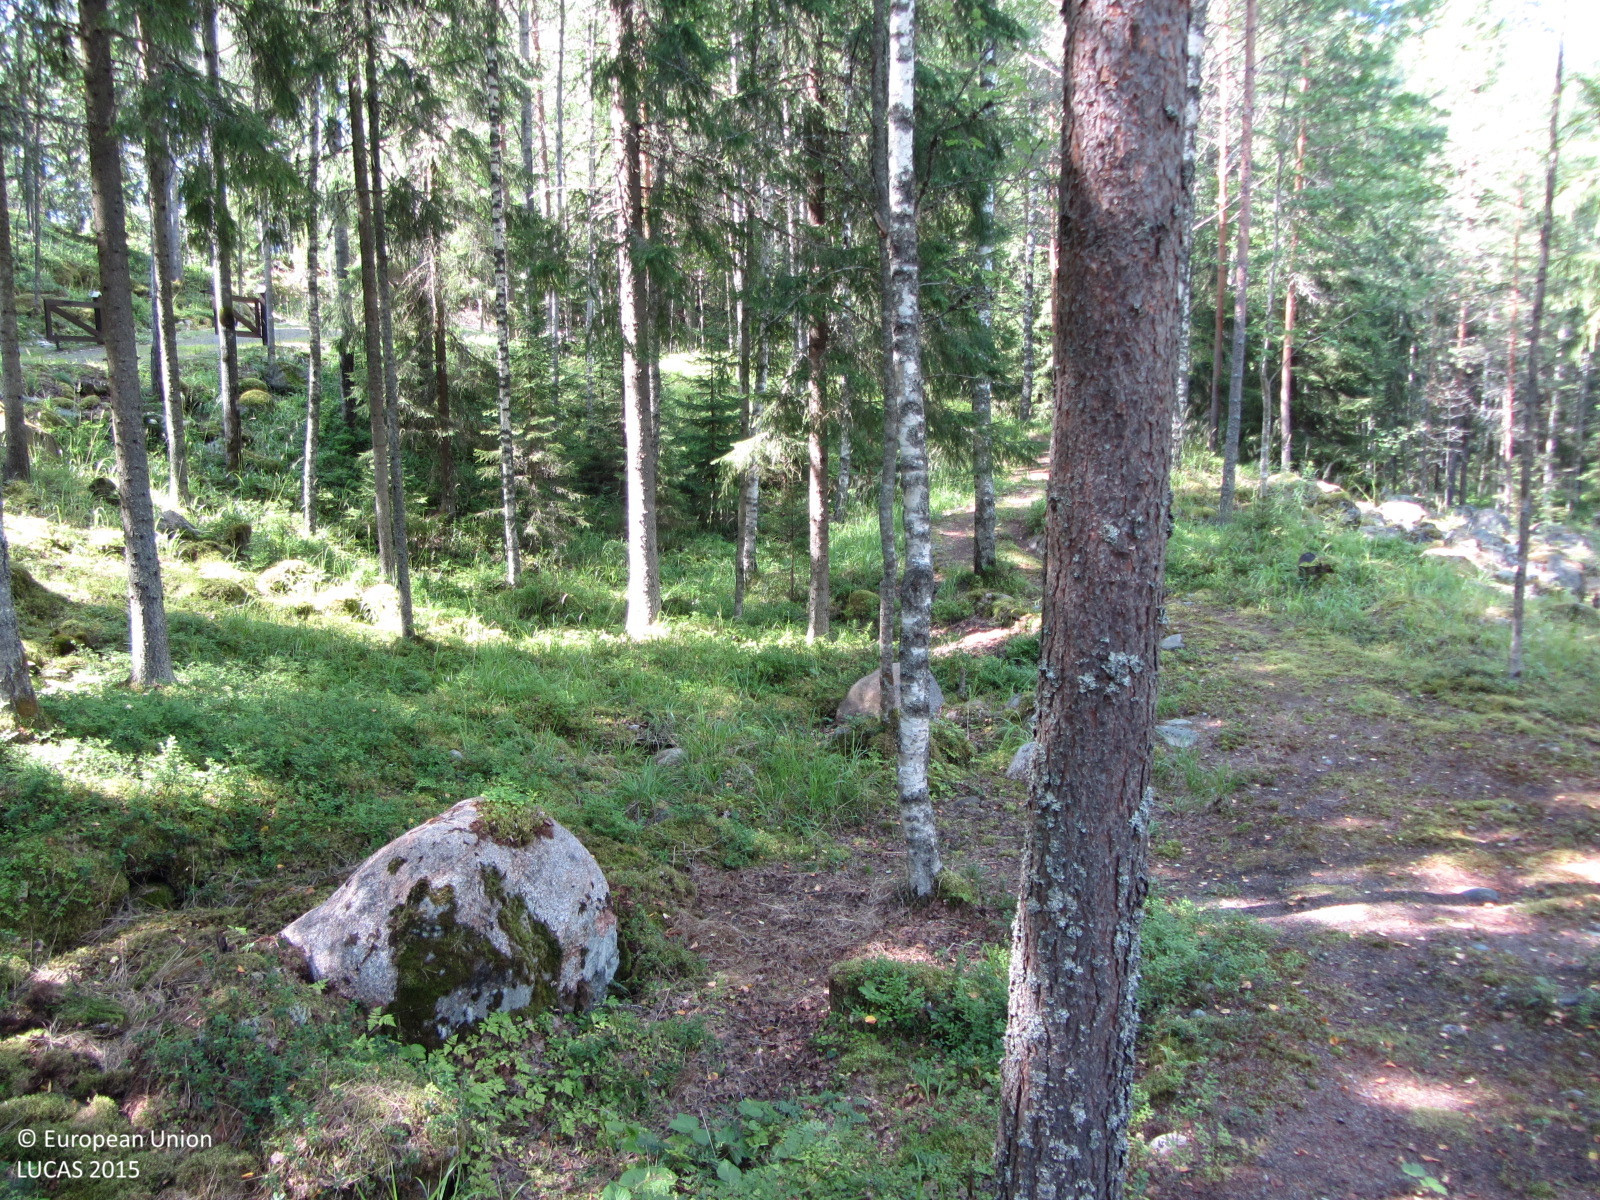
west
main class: Woodland
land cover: Pine dominated mixed woodland
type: boreal forest
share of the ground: 50 - 75 %
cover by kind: coniferous forest trees 30 %, broadleaved forest trees 30 %, shrubs 20 %, lichens and mosses 15 %, unconsolidated bare surface 5 %
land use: Forestry
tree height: > 5 m
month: July
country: FI
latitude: 60.6311
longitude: 24.3790
